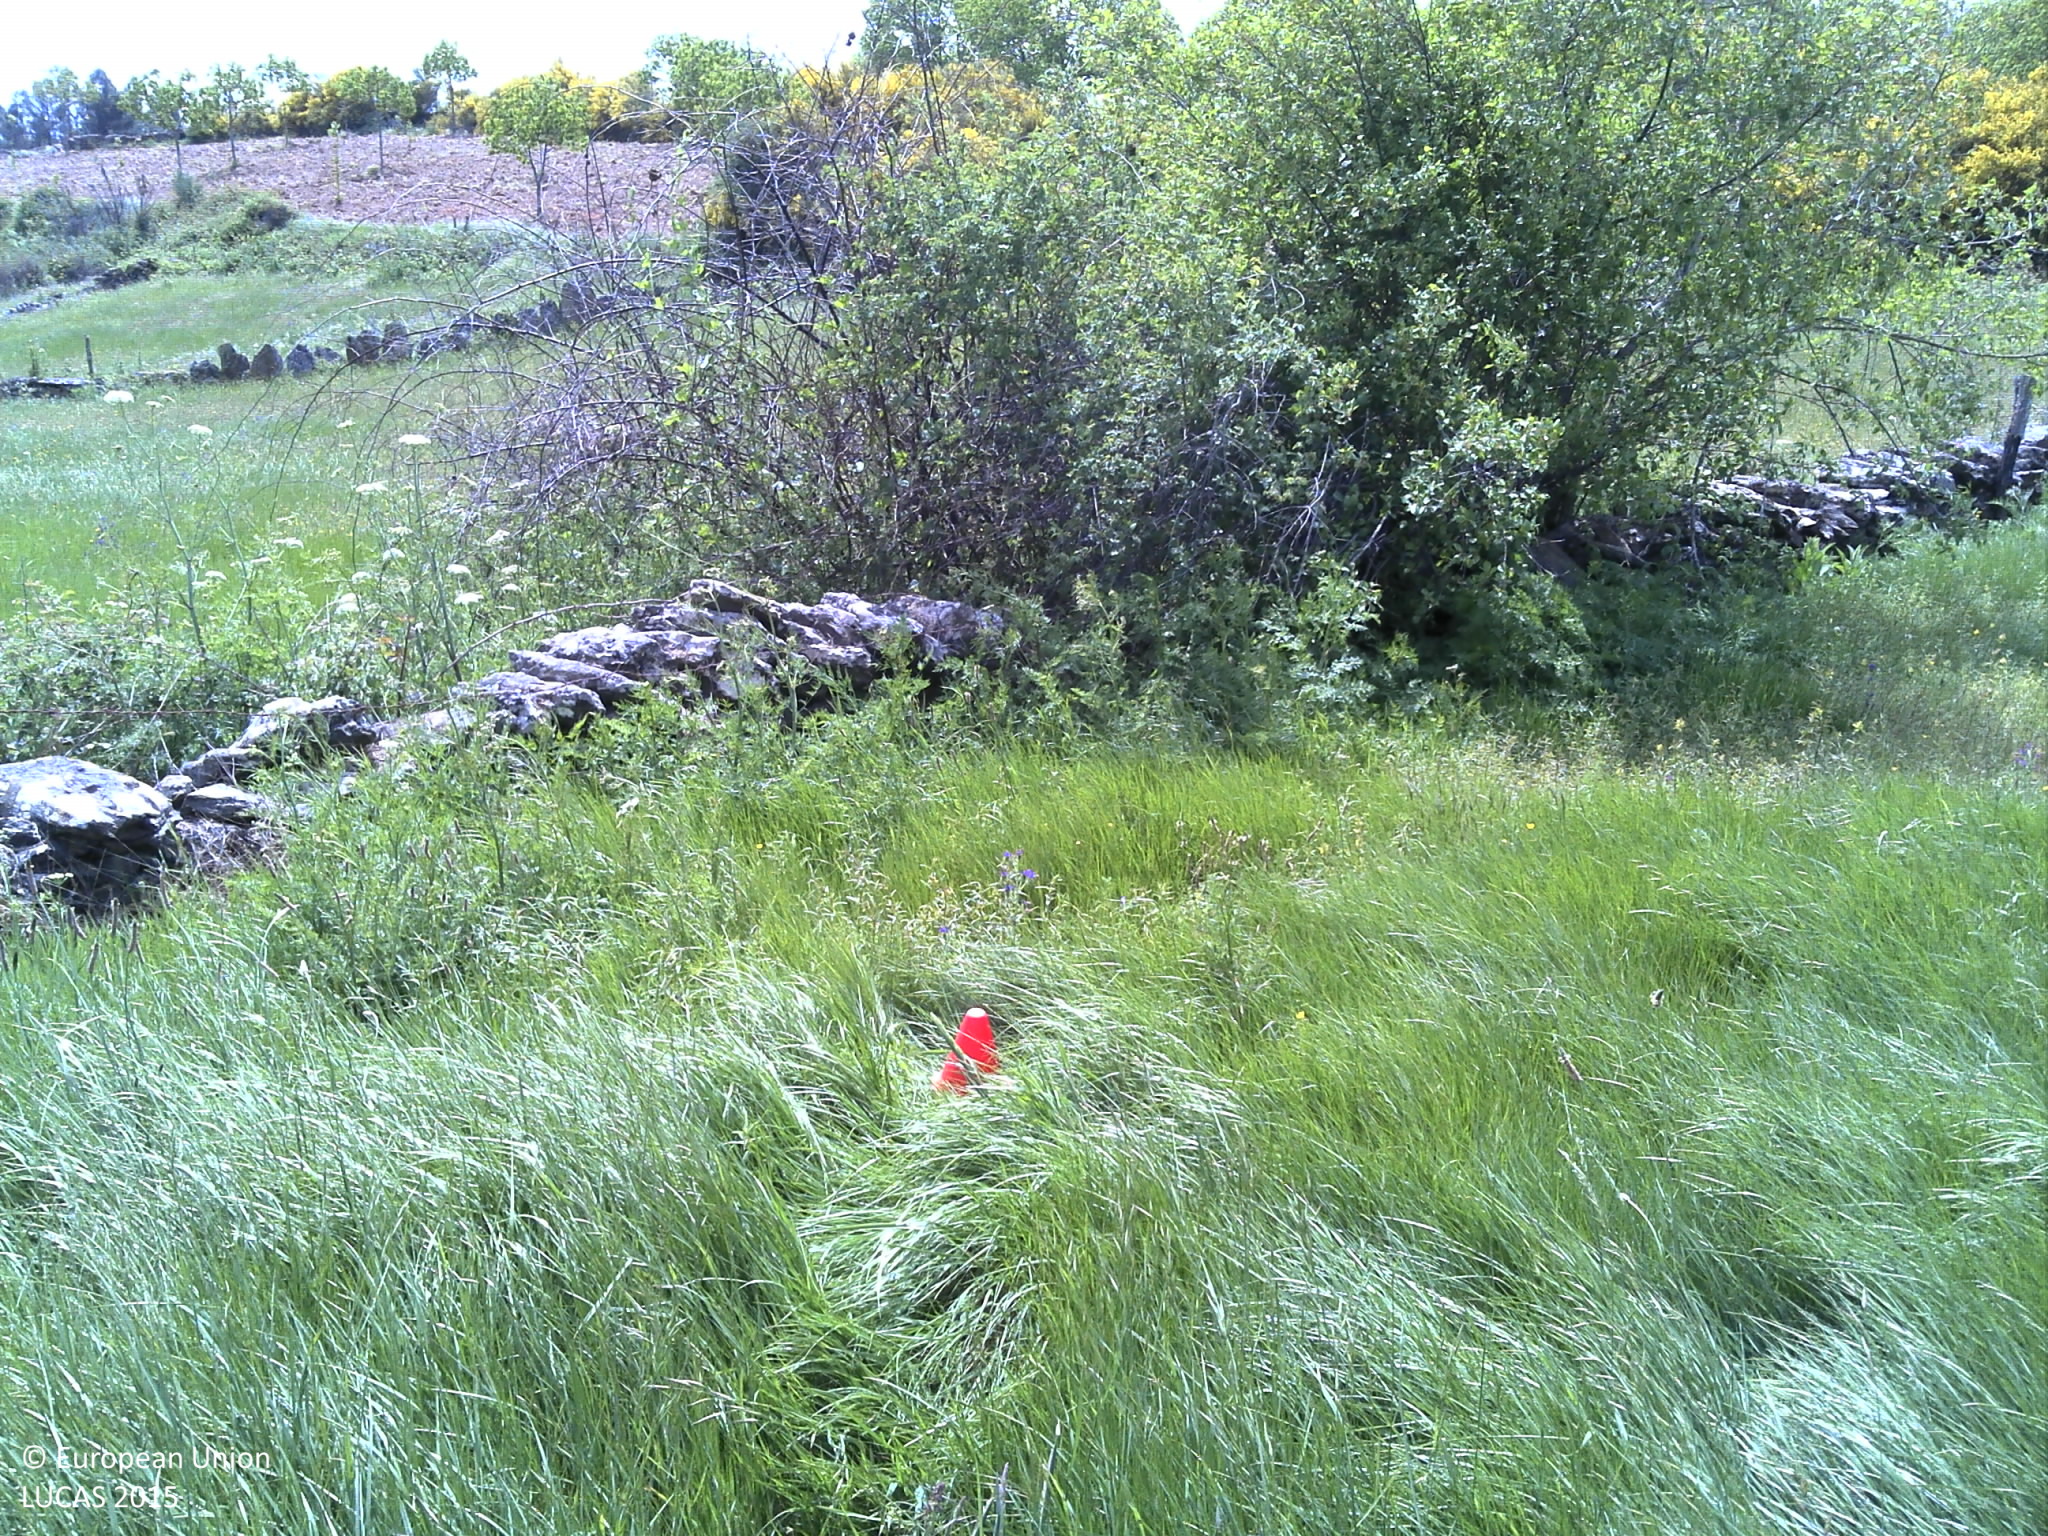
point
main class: Grassland
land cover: Grassland without tree/shrub cover
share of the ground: > 75 %
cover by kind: herbaceous plants 100 %
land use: Agriculture (excluding fallow land and kitchen gardens)
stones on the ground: < 10 %
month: May
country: PT
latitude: 41.5277
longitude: -7.4685
